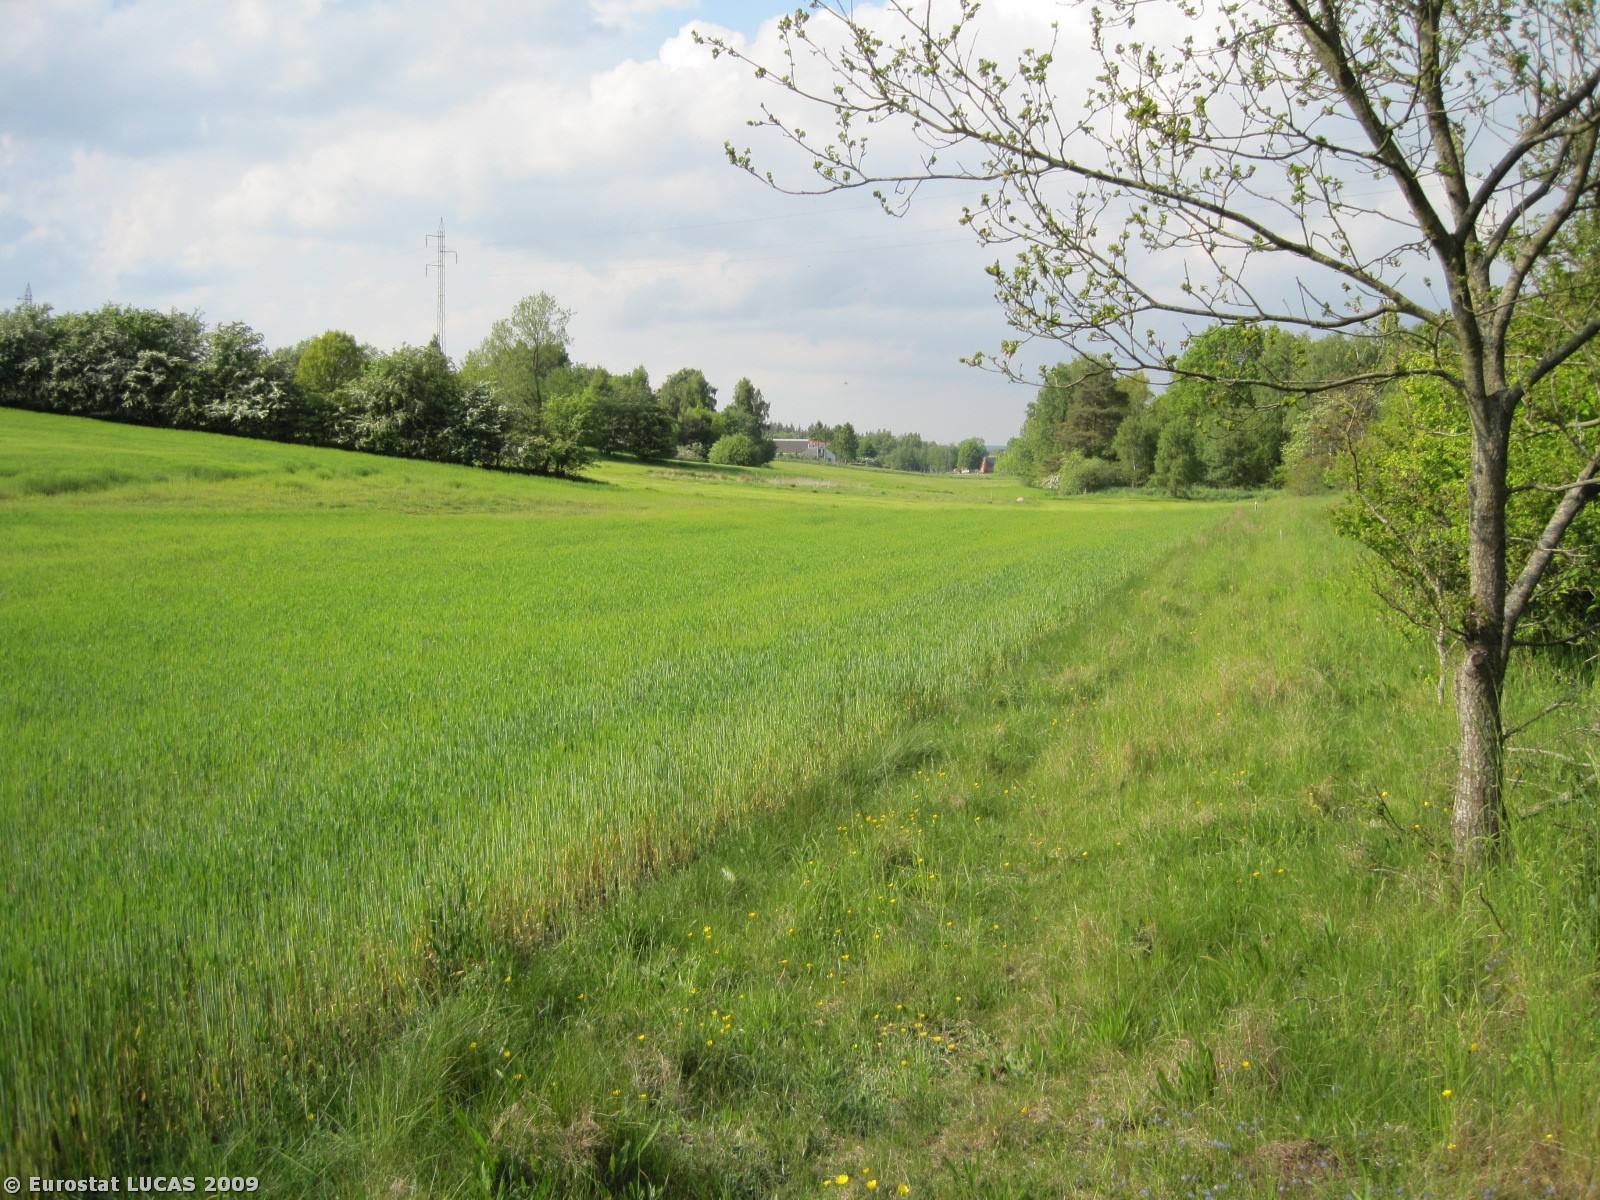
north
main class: Grassland
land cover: Grassland without tree/shrub cover
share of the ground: > 75 %
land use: Unused
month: May
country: DK
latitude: 56.6910
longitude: 10.1467
